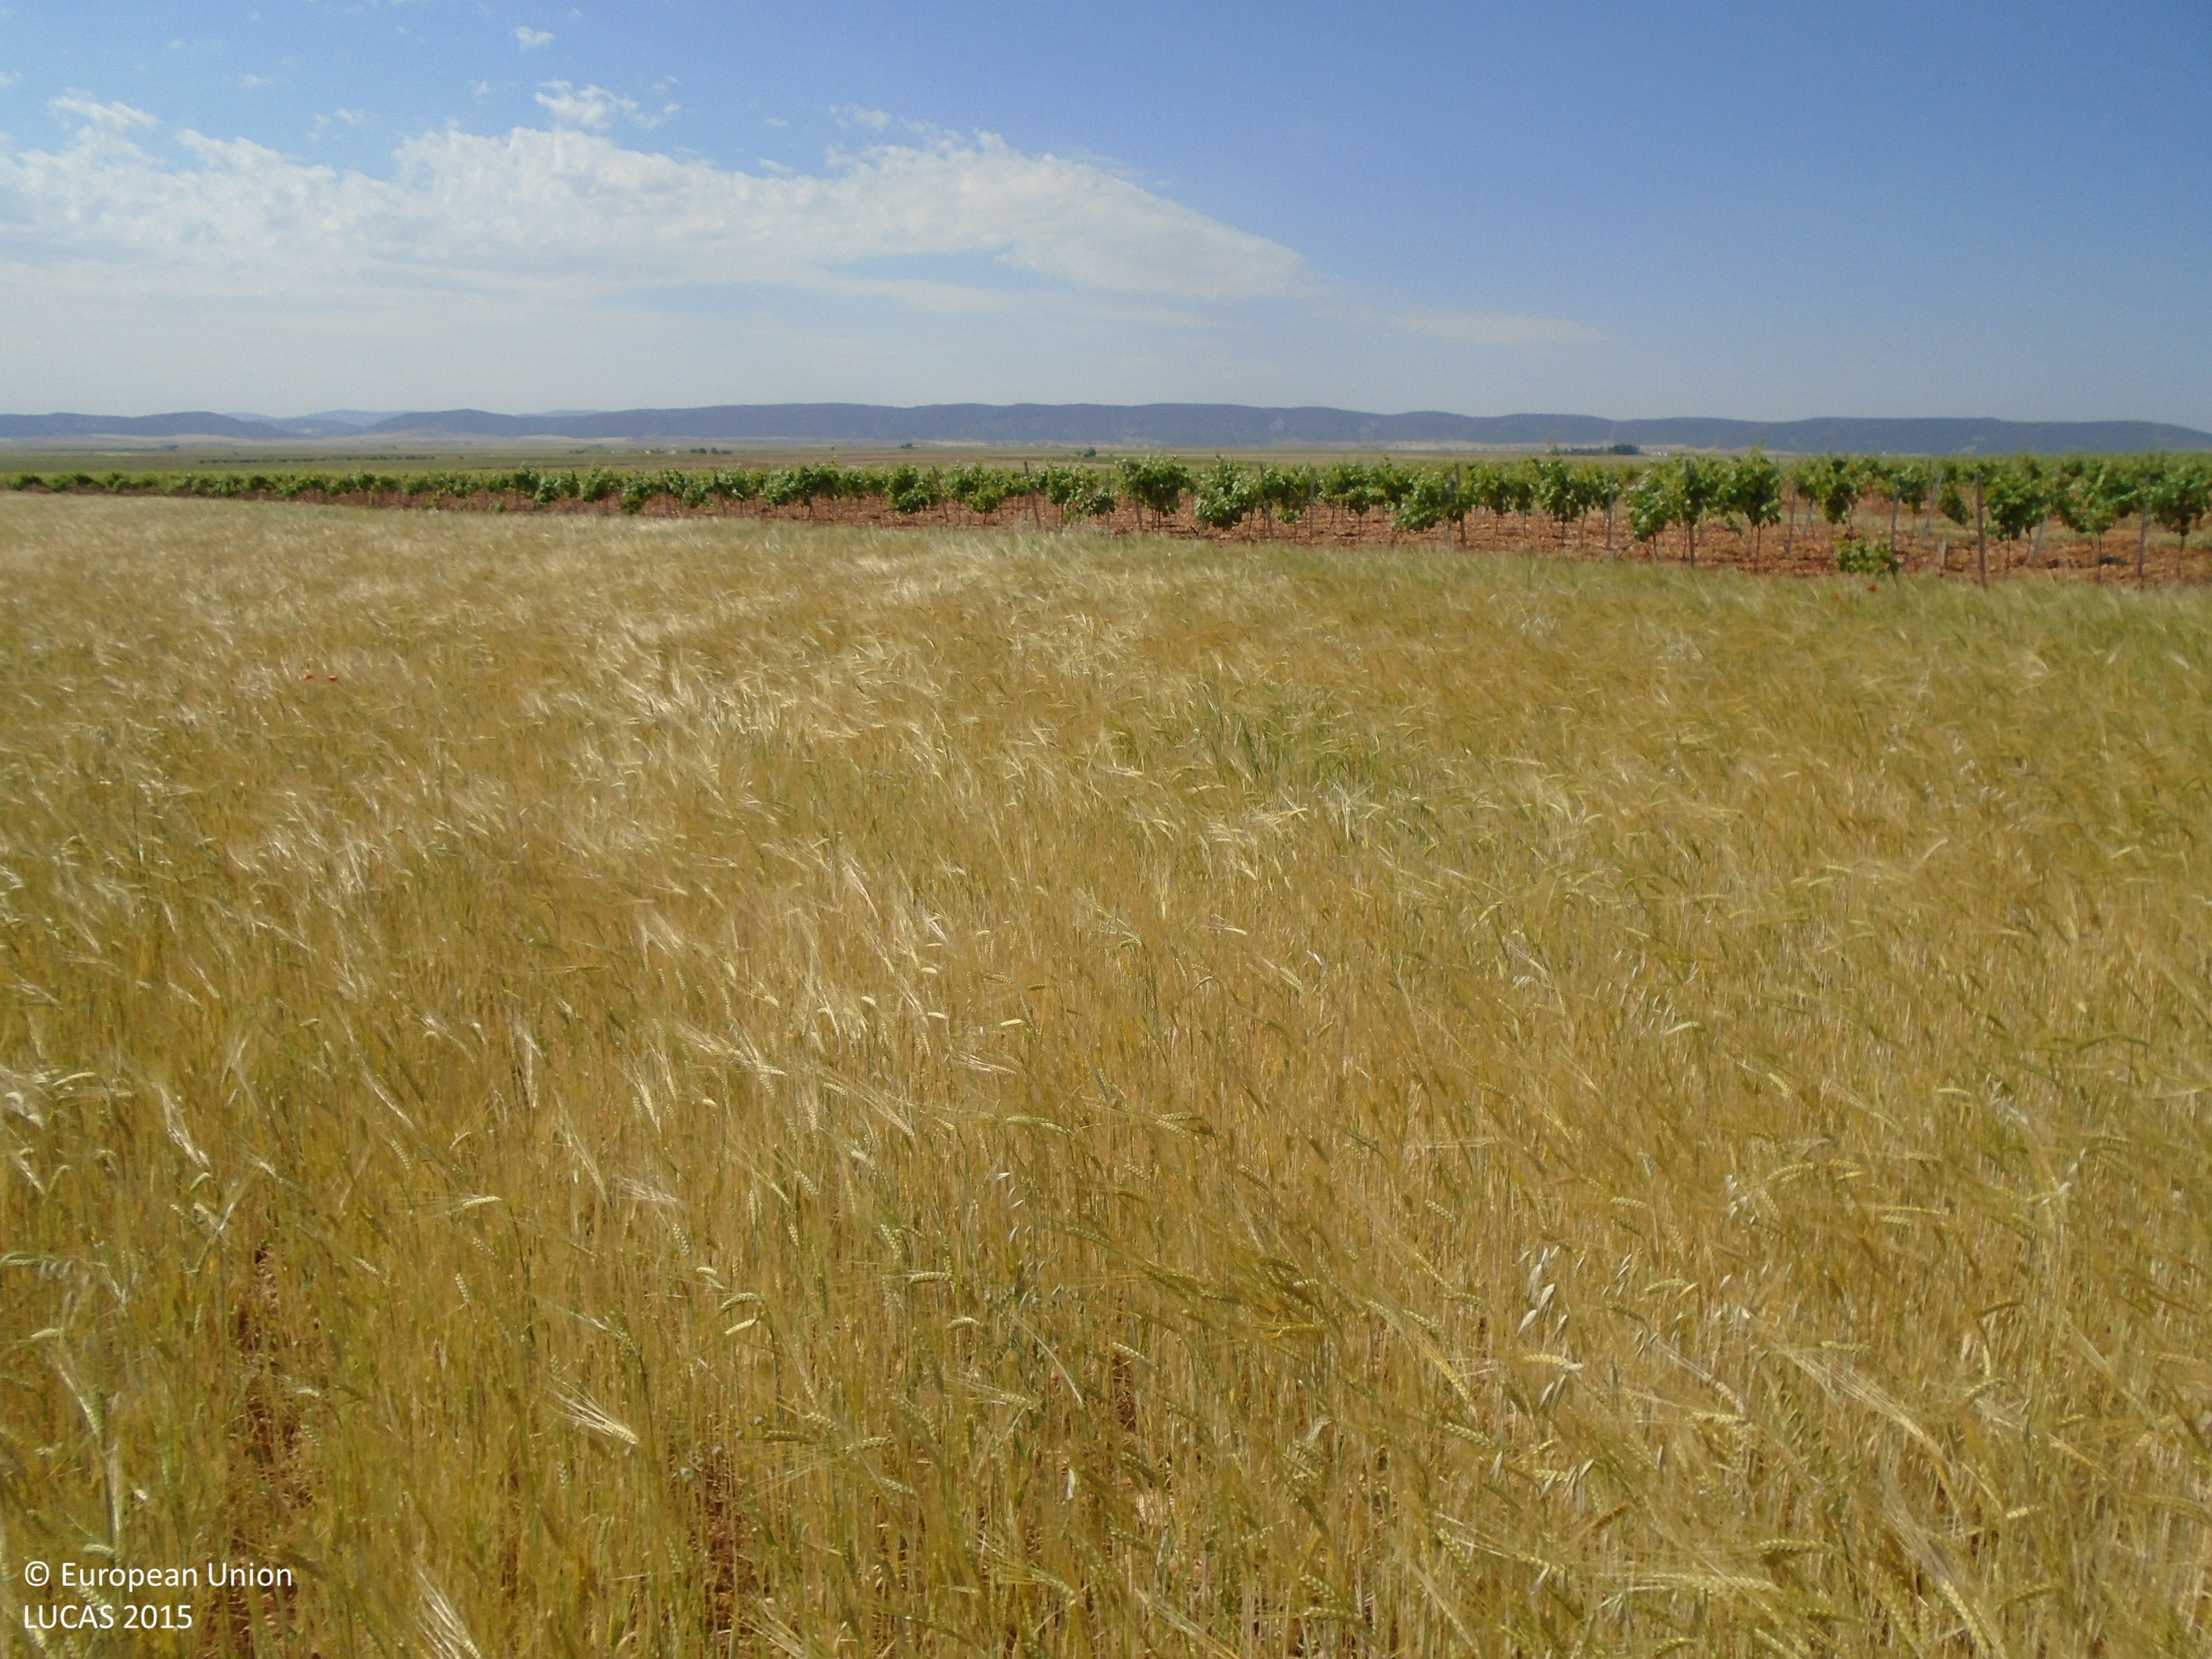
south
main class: Cropland
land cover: Barley
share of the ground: > 75 %
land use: Agriculture (excluding fallow land and kitchen gardens)
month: May
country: ES
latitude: 39.5511
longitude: -3.7470
